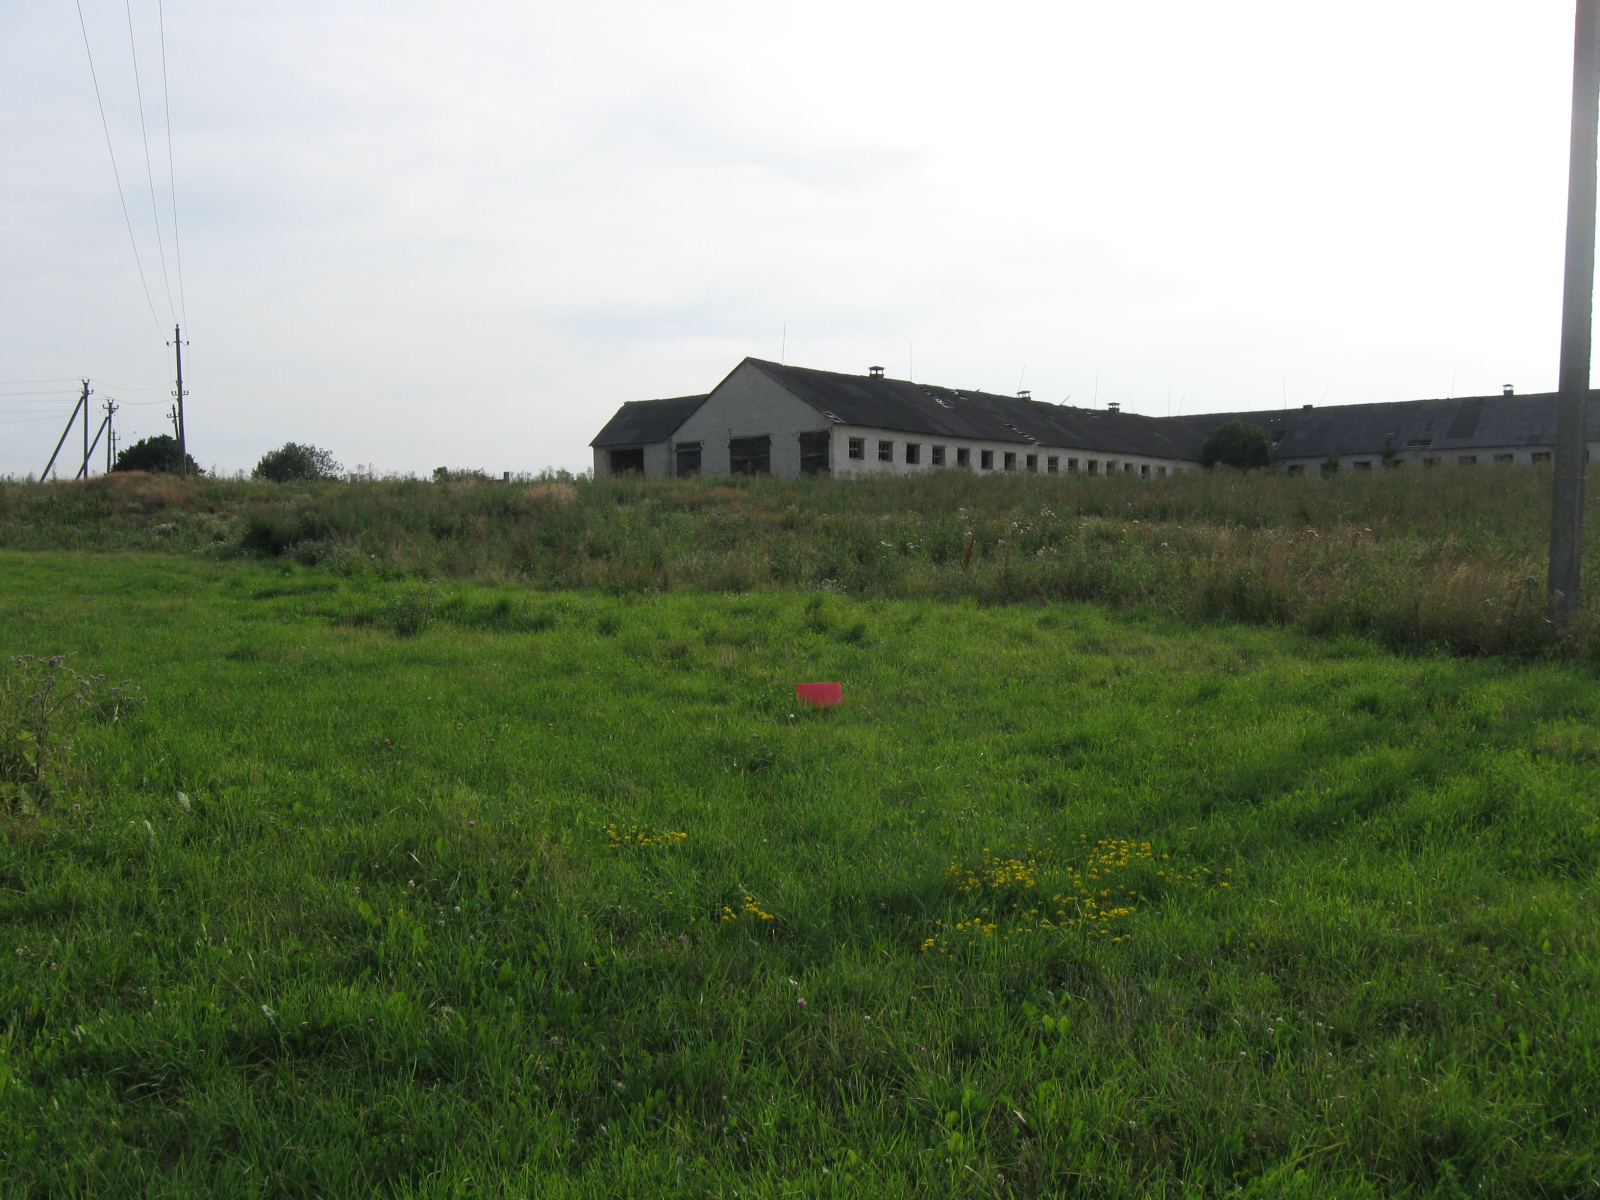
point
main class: Grassland
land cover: Grassland without tree/shrub cover
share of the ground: > 75 %
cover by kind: herbaceous plants 100 %
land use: Agriculture (excluding fallow land and kitchen gardens)
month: July
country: LT
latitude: 54.6723
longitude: 23.7795
